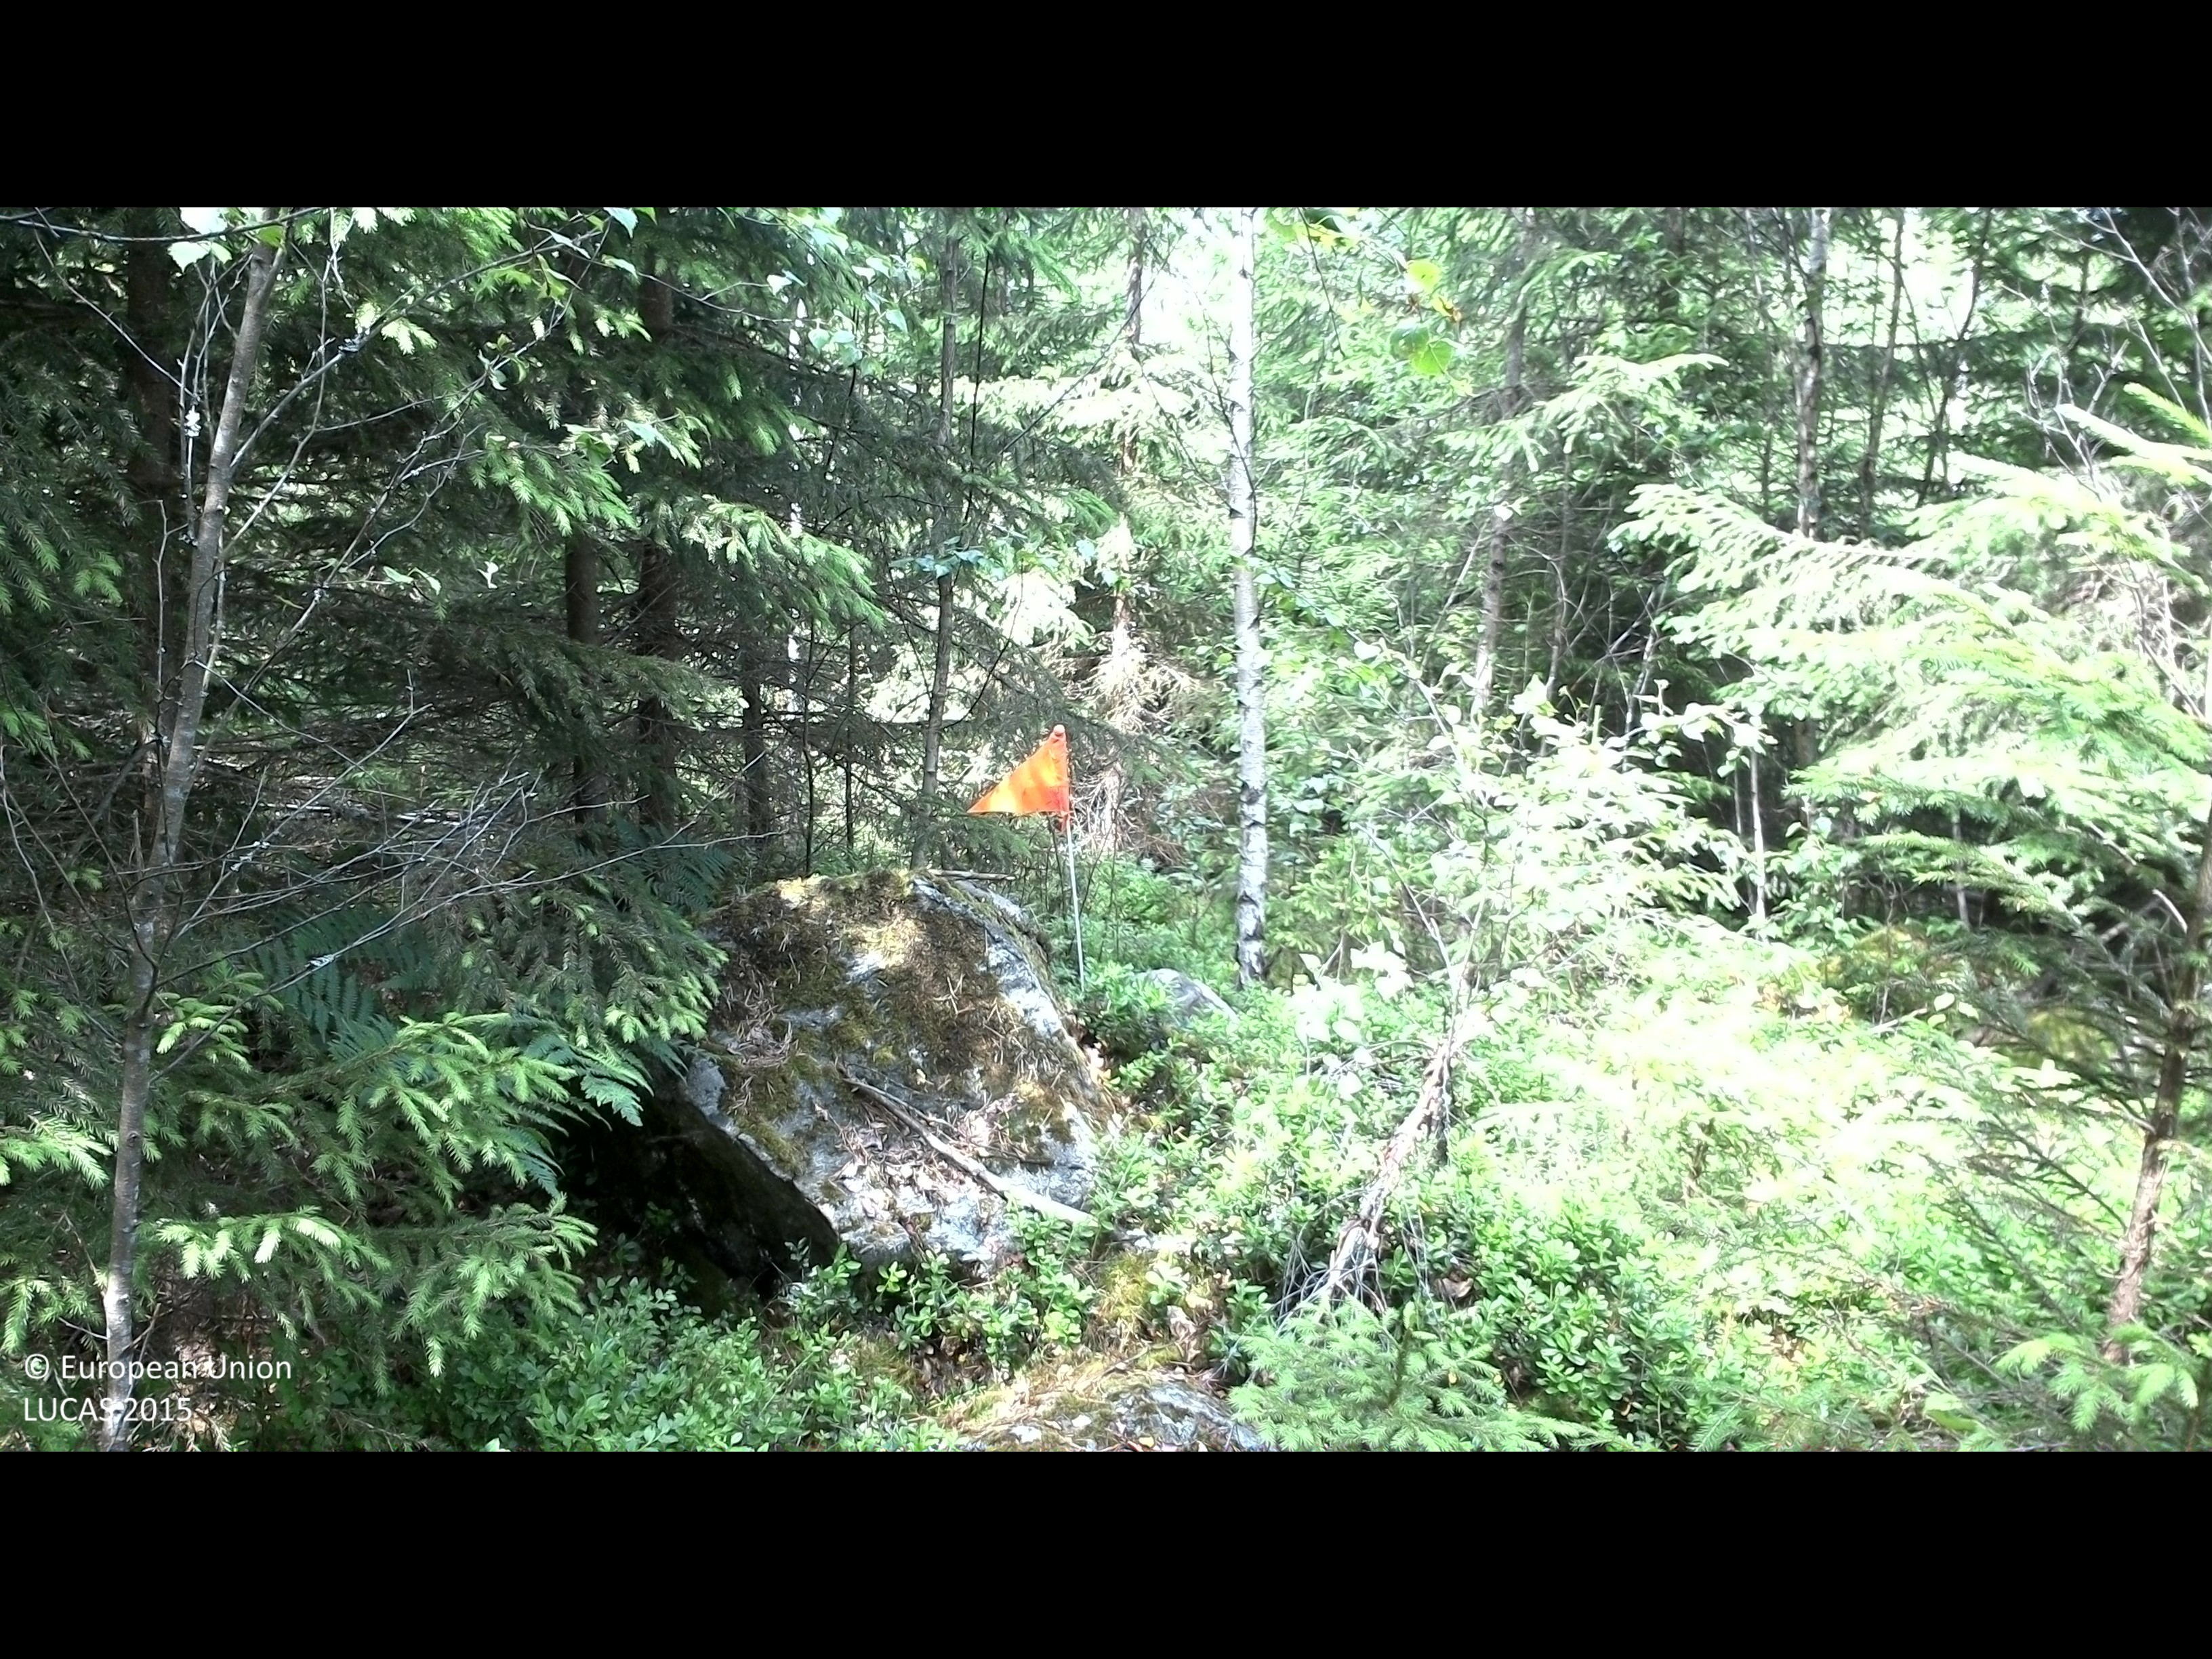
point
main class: Woodland
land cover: Spruce dominated coniferous woodland
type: boreal forest
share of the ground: > 75 %
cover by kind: coniferous forest trees 75 %, shrubs 10 %, broadleaved forest trees 5 %, herbaceous plants 5 %, lichens and mosses 5 %
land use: Forestry
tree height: > 5 m
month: July
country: SE
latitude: 56.3543
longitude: 15.1611
